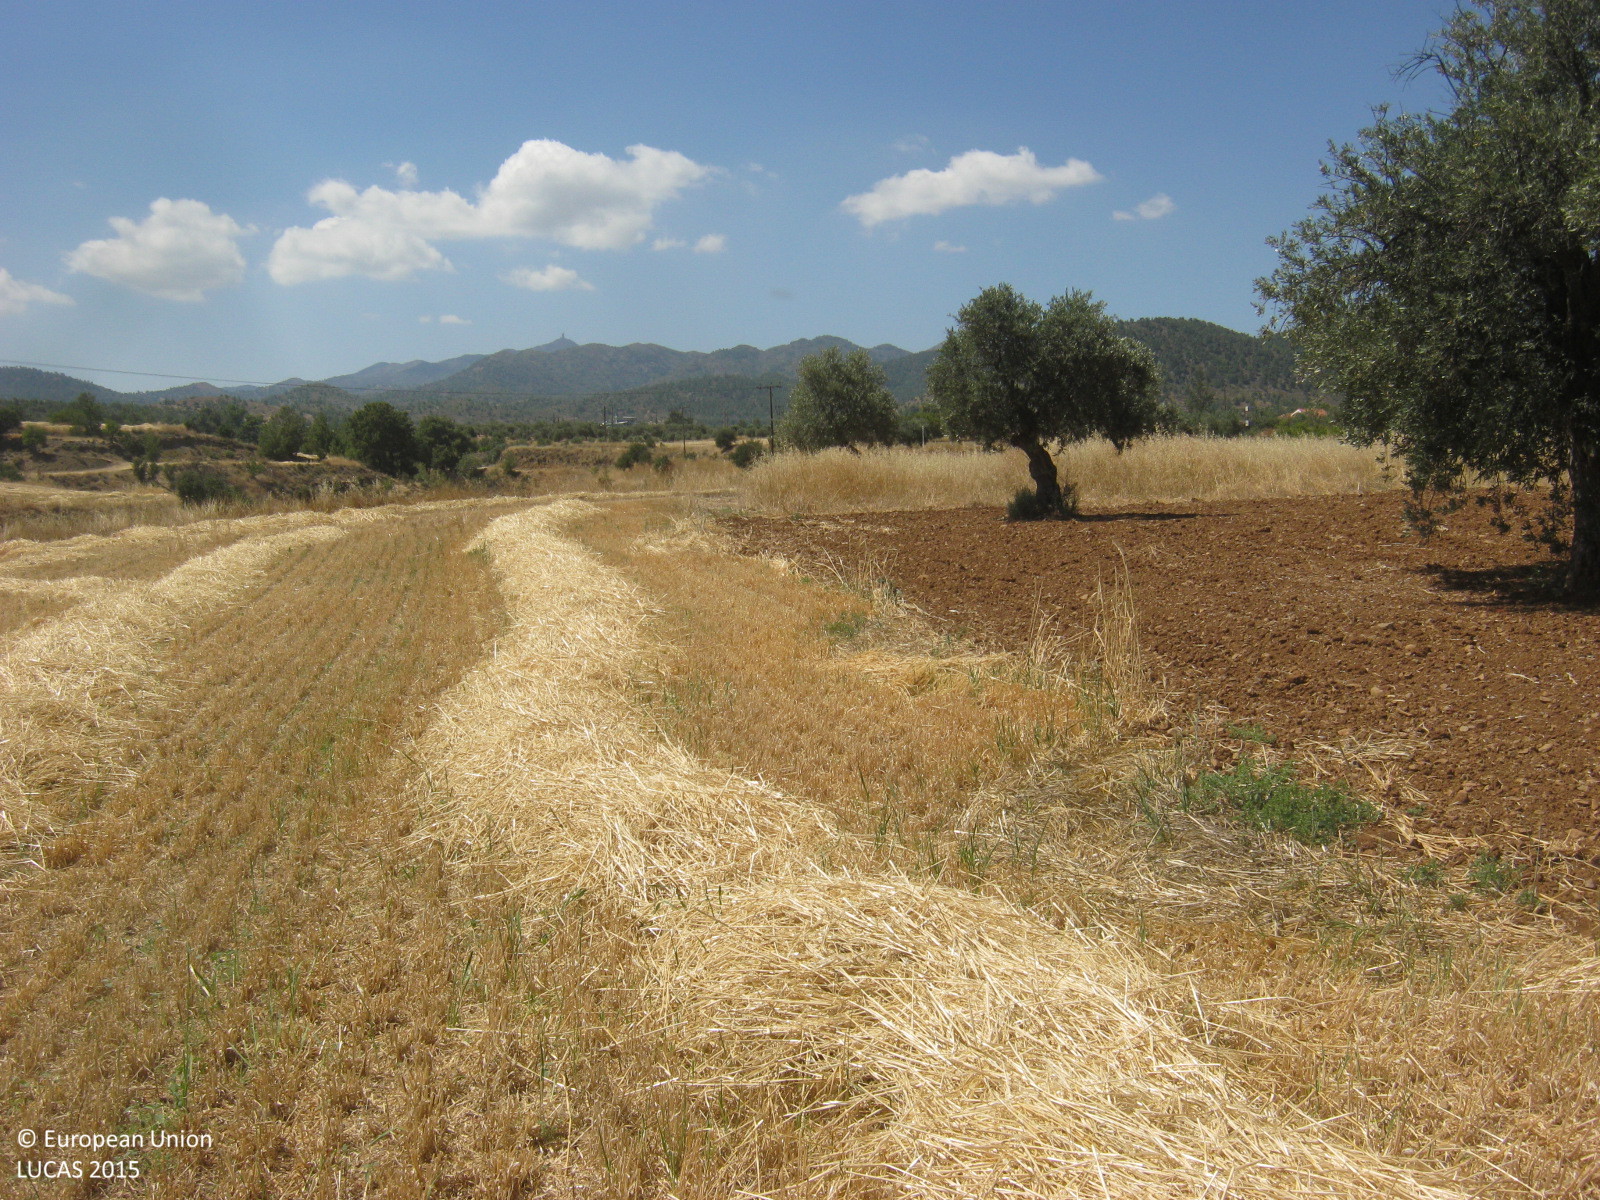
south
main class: Cropland
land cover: Barley
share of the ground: < 10 %
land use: Agriculture (excluding fallow land and kitchen gardens)
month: June
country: CY
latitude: 35.0271
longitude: 33.1880
